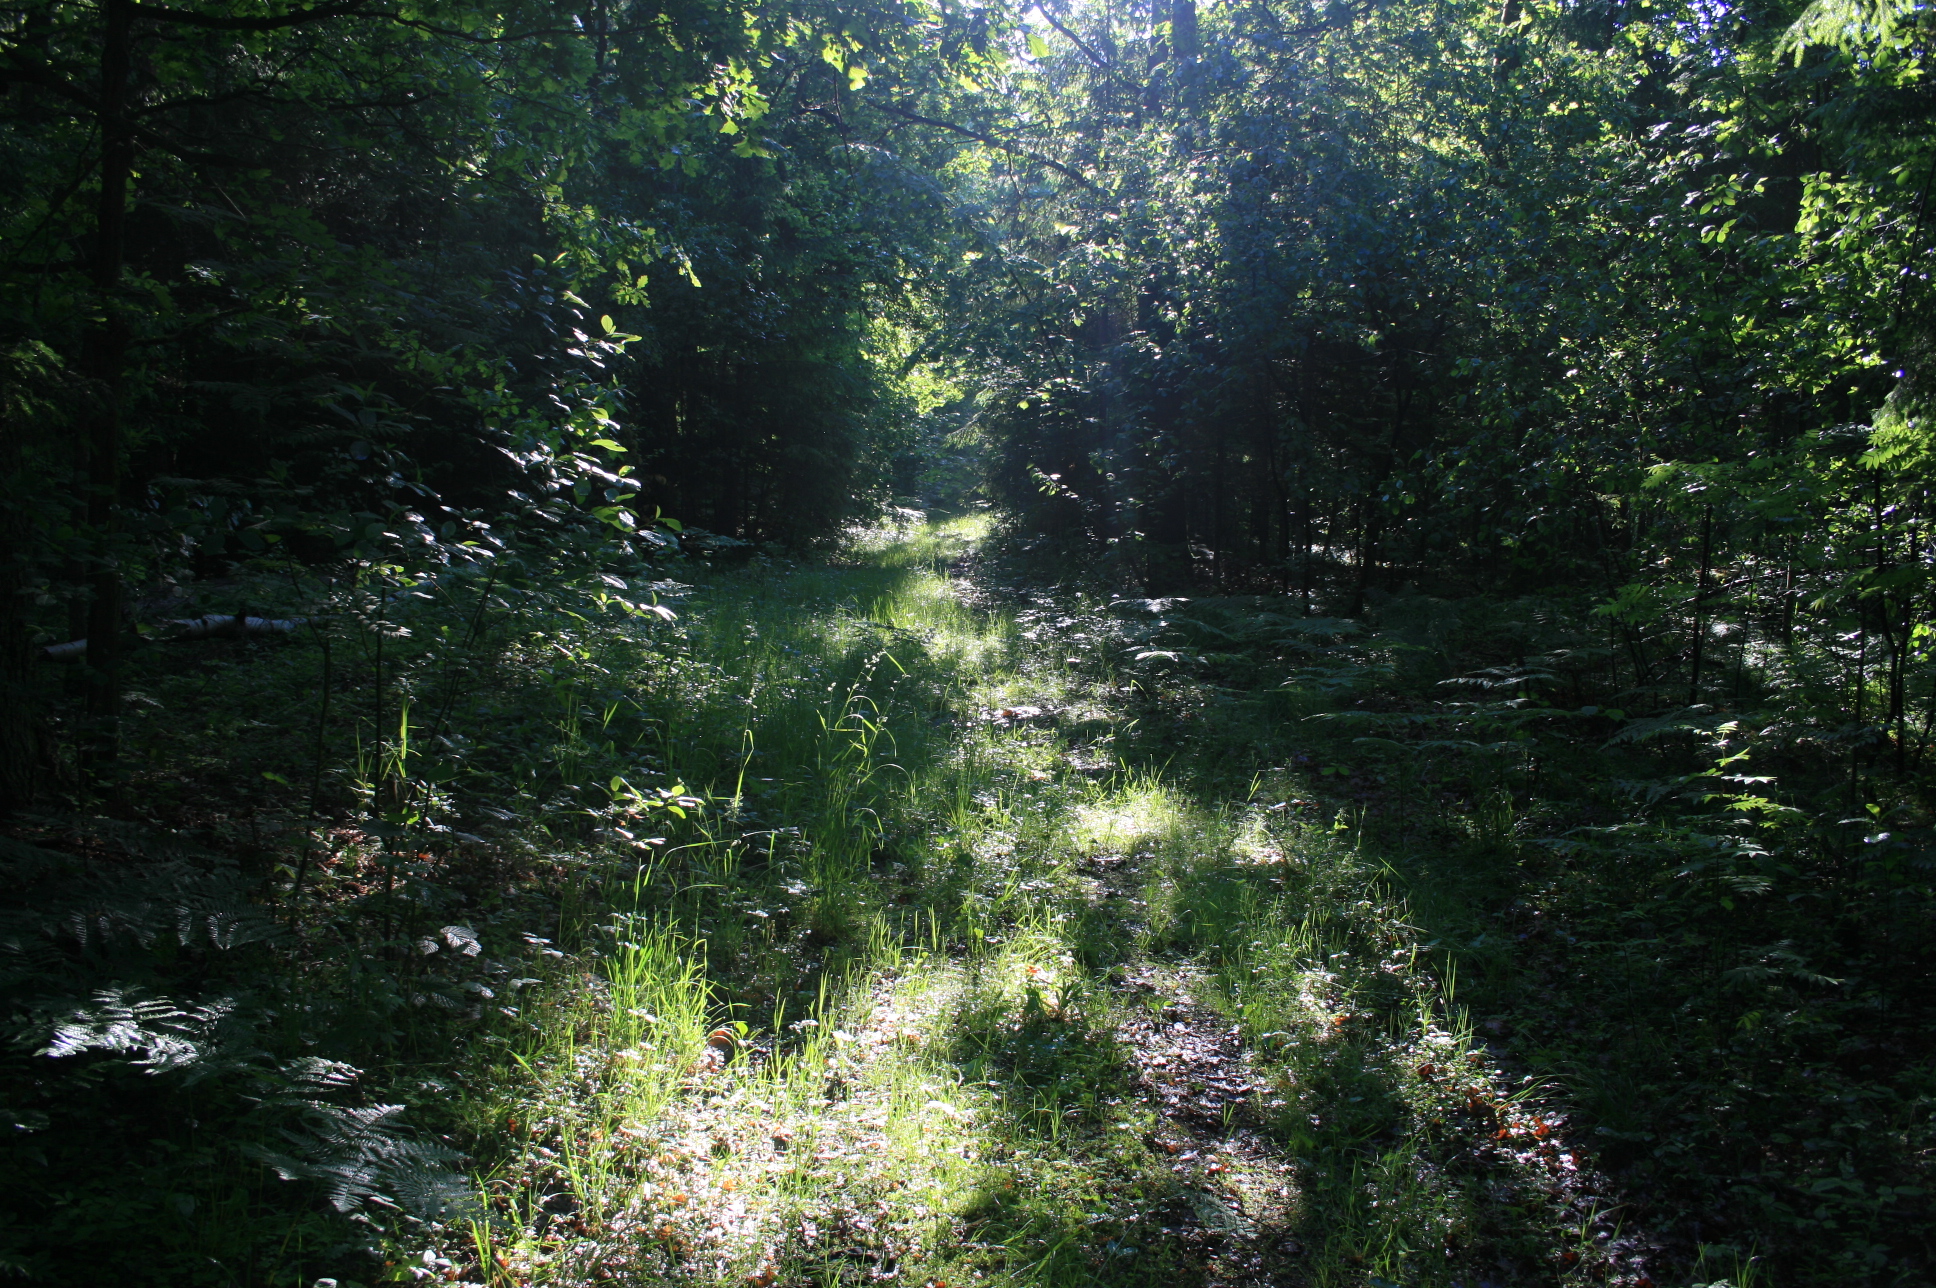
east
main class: Woodland
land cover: Spruce dominated mixed woodland
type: hemiboreal forest and nemoral coniferous forest and mixed broadleaved-coniferous forest
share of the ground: > 75 %
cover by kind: coniferous forest trees 60 %, broadleaved forest trees 25 %, herbaceous plants 15 %
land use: Forestry
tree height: > 5 m
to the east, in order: Spruce dominated mixed woodland; Tracks; Abandoned hedges; Ditches and canals; Spruce dominated mixed woodland; Tracks; Spruce dominated mixed woodland; Ditches and canals; Spruce dominated mixed woodland; Tracks; Spruce dominated mixed woodland; Tracks; Spruce dominated mixed woodland; Tracks
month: June
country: LT
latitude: 55.2345
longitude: 22.2445
